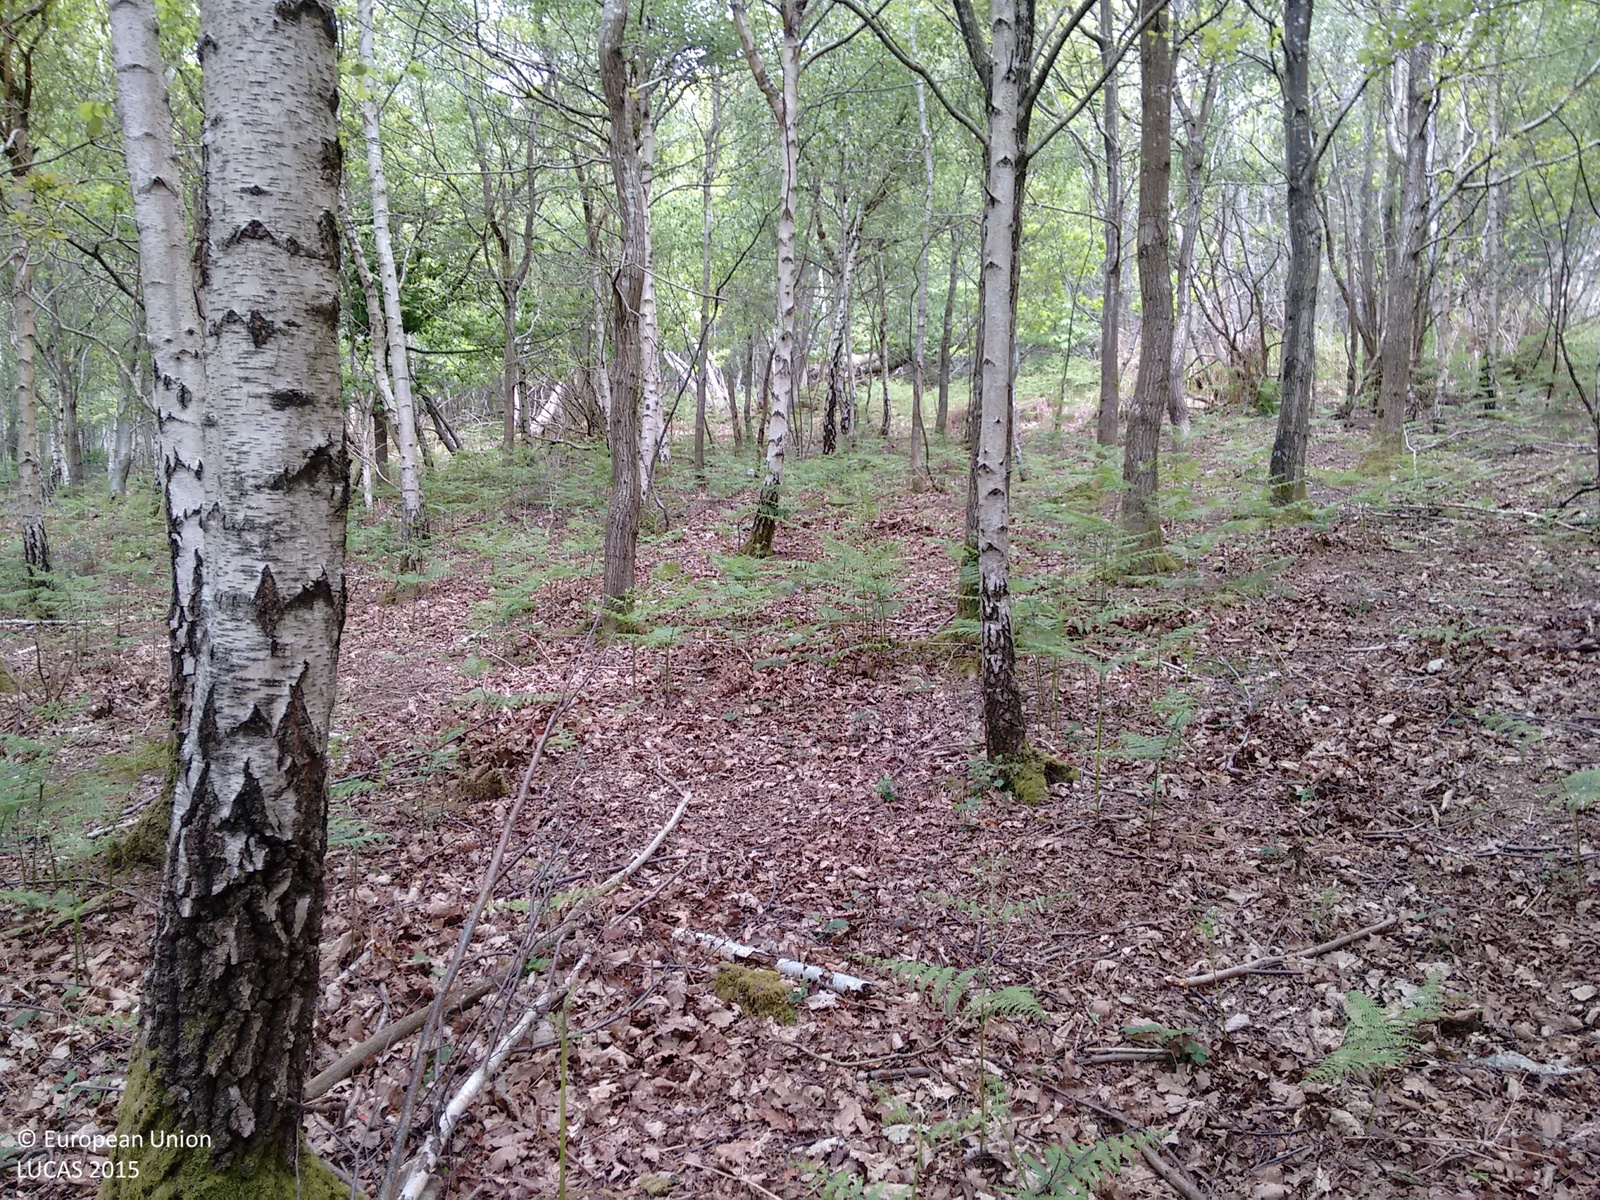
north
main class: Woodland
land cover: Broadleaved woodland
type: mesophytic deciduous forest
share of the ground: > 75 %
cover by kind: broadleaved forest trees 95 %, coniferous forest trees 5 %
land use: Forestry
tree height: > 5 m
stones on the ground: < 10 %
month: May
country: GB
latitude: 51.1125
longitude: 0.3286
